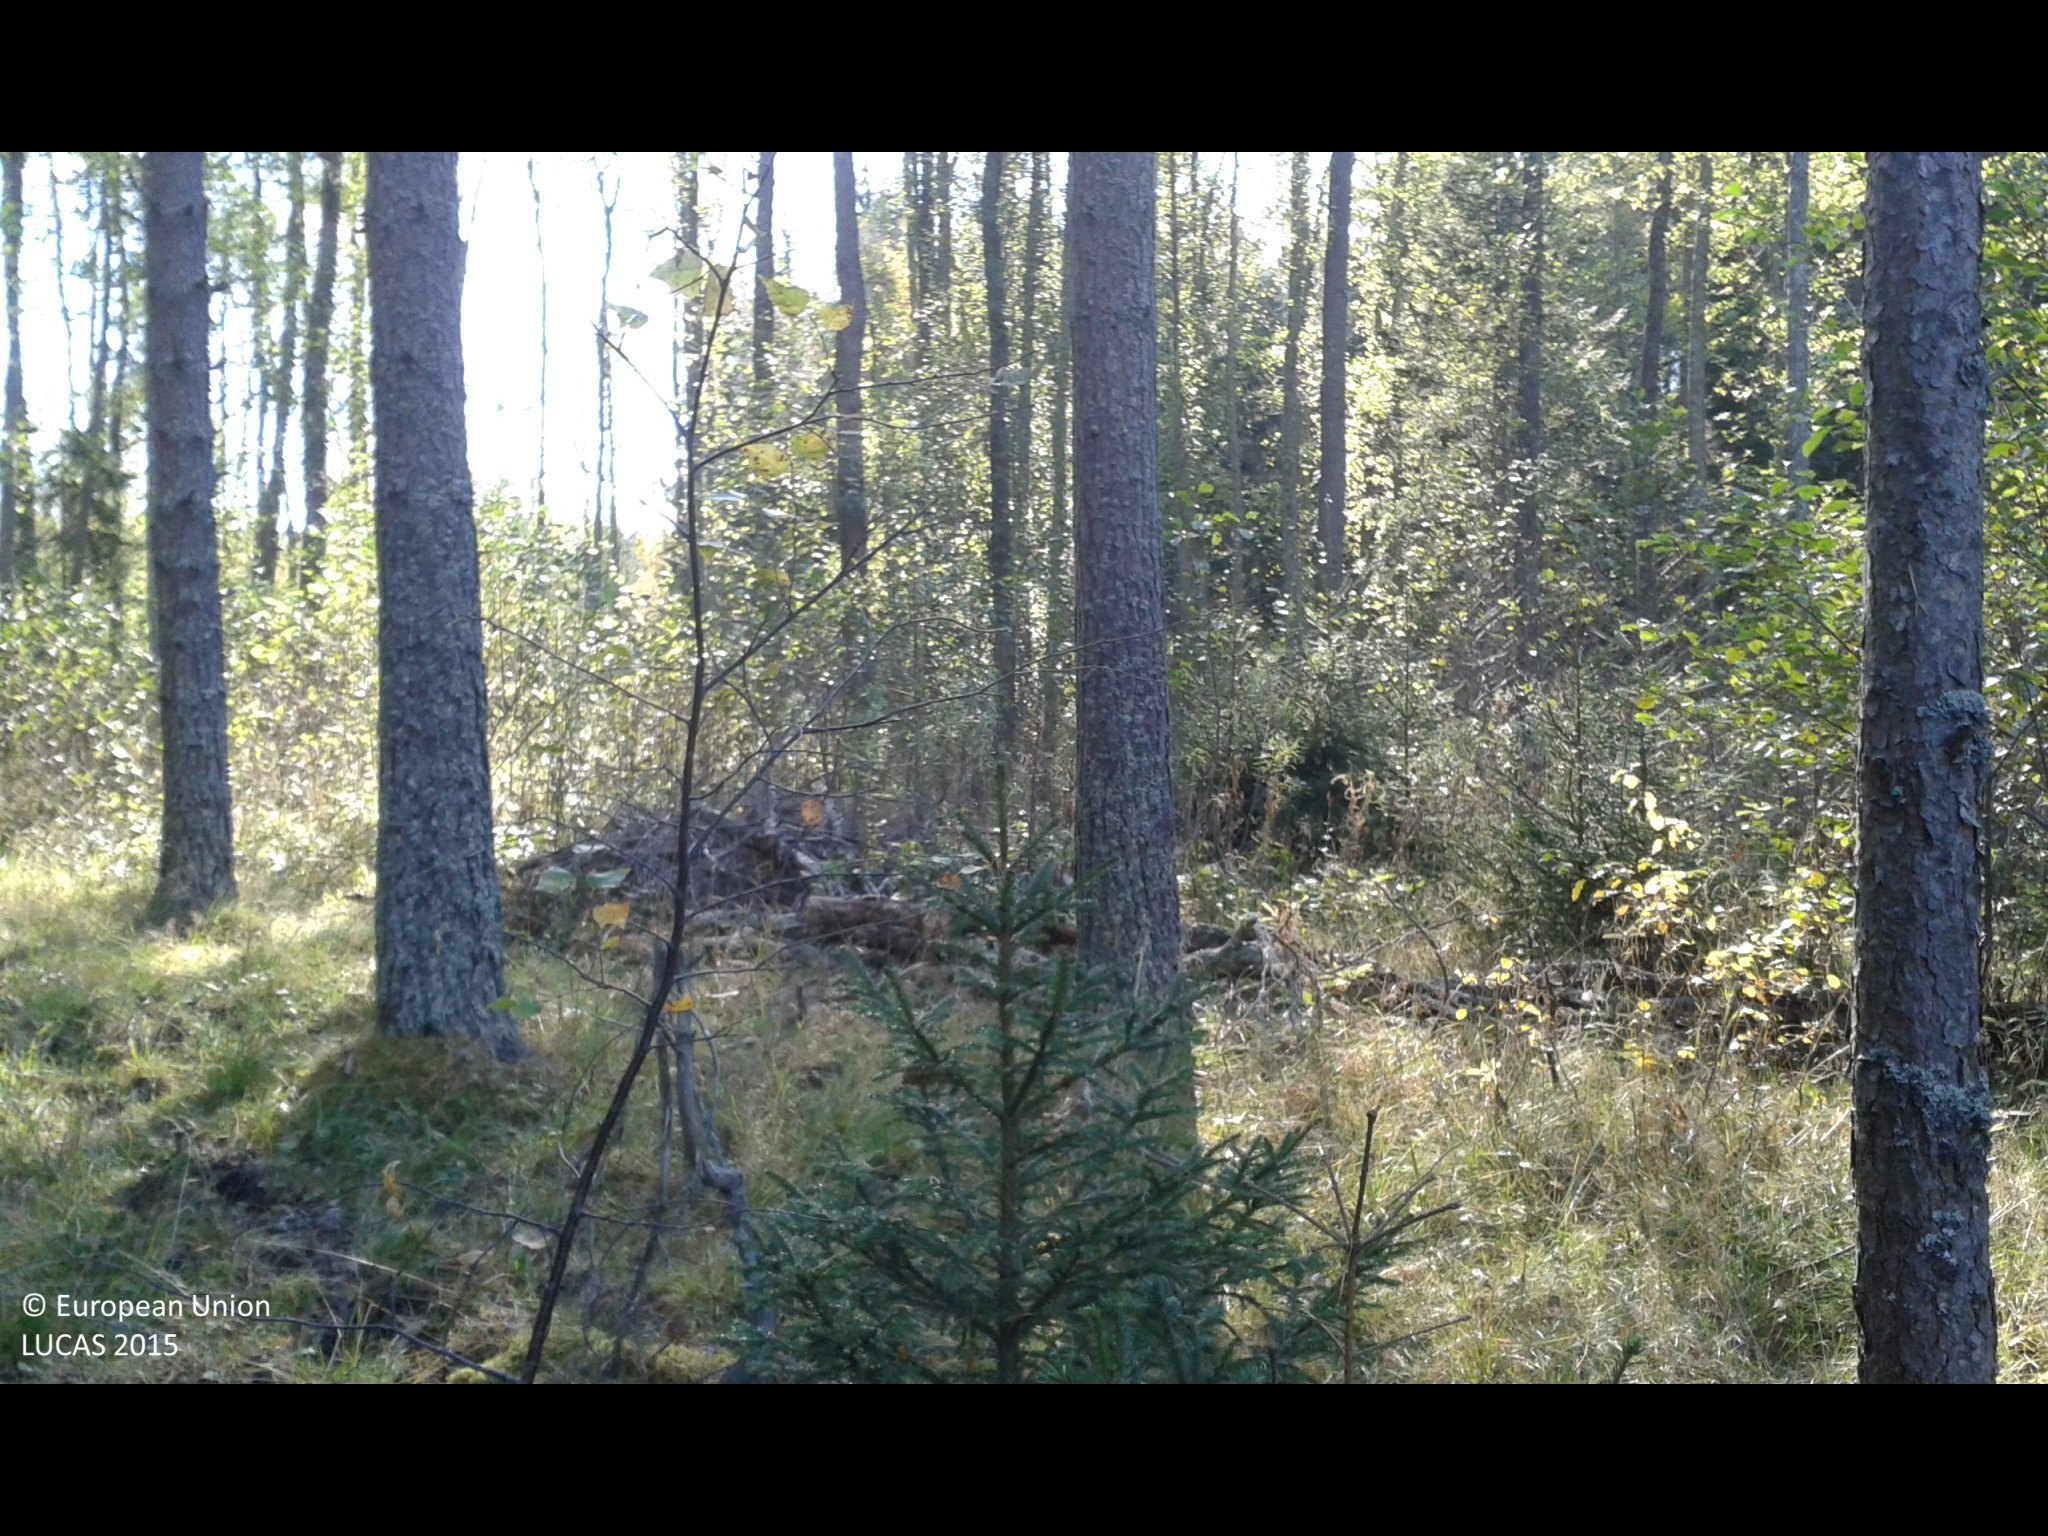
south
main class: Woodland
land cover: Pine dominated mixed woodland
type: boreal forest
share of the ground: 50 - 75 %
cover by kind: coniferous forest trees 40 %, broadleaved forest trees 30 %, shrubs 30 %
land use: Forestry
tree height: > 5 m
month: October
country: SE
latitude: 58.8188
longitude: 17.2529
